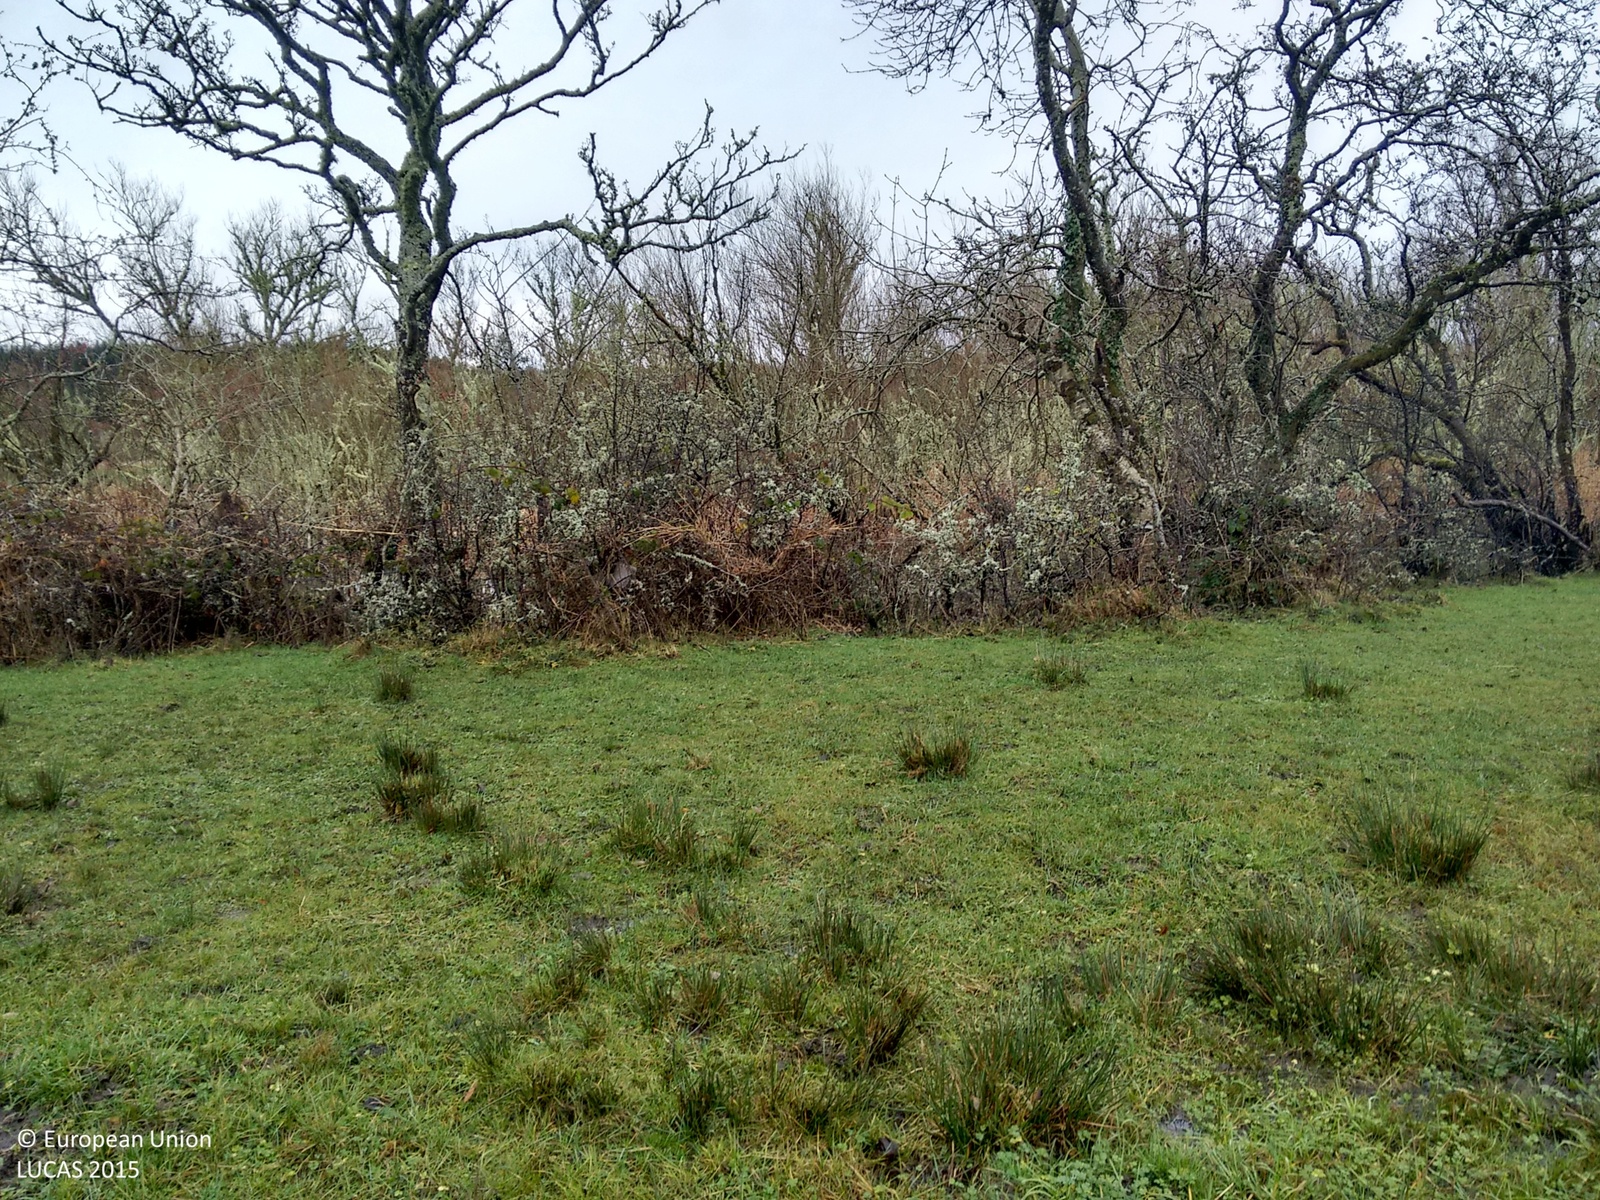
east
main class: Grassland
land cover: Grassland without tree/shrub cover
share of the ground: > 75 %
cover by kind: herbaceous plants 100 %
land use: Semi-natural and natural areas not in use
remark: Temporary flooded
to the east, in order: Grassland without tree/shrub cover; Lines of trees; Tracks; Grassland without tree/shrub cover; Abandoned hedges; Inland marshes; Inland fresh running water; Lines of trees; Grassland without tree/shrub cover
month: November
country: IE
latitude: 54.2379
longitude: -8.3369
